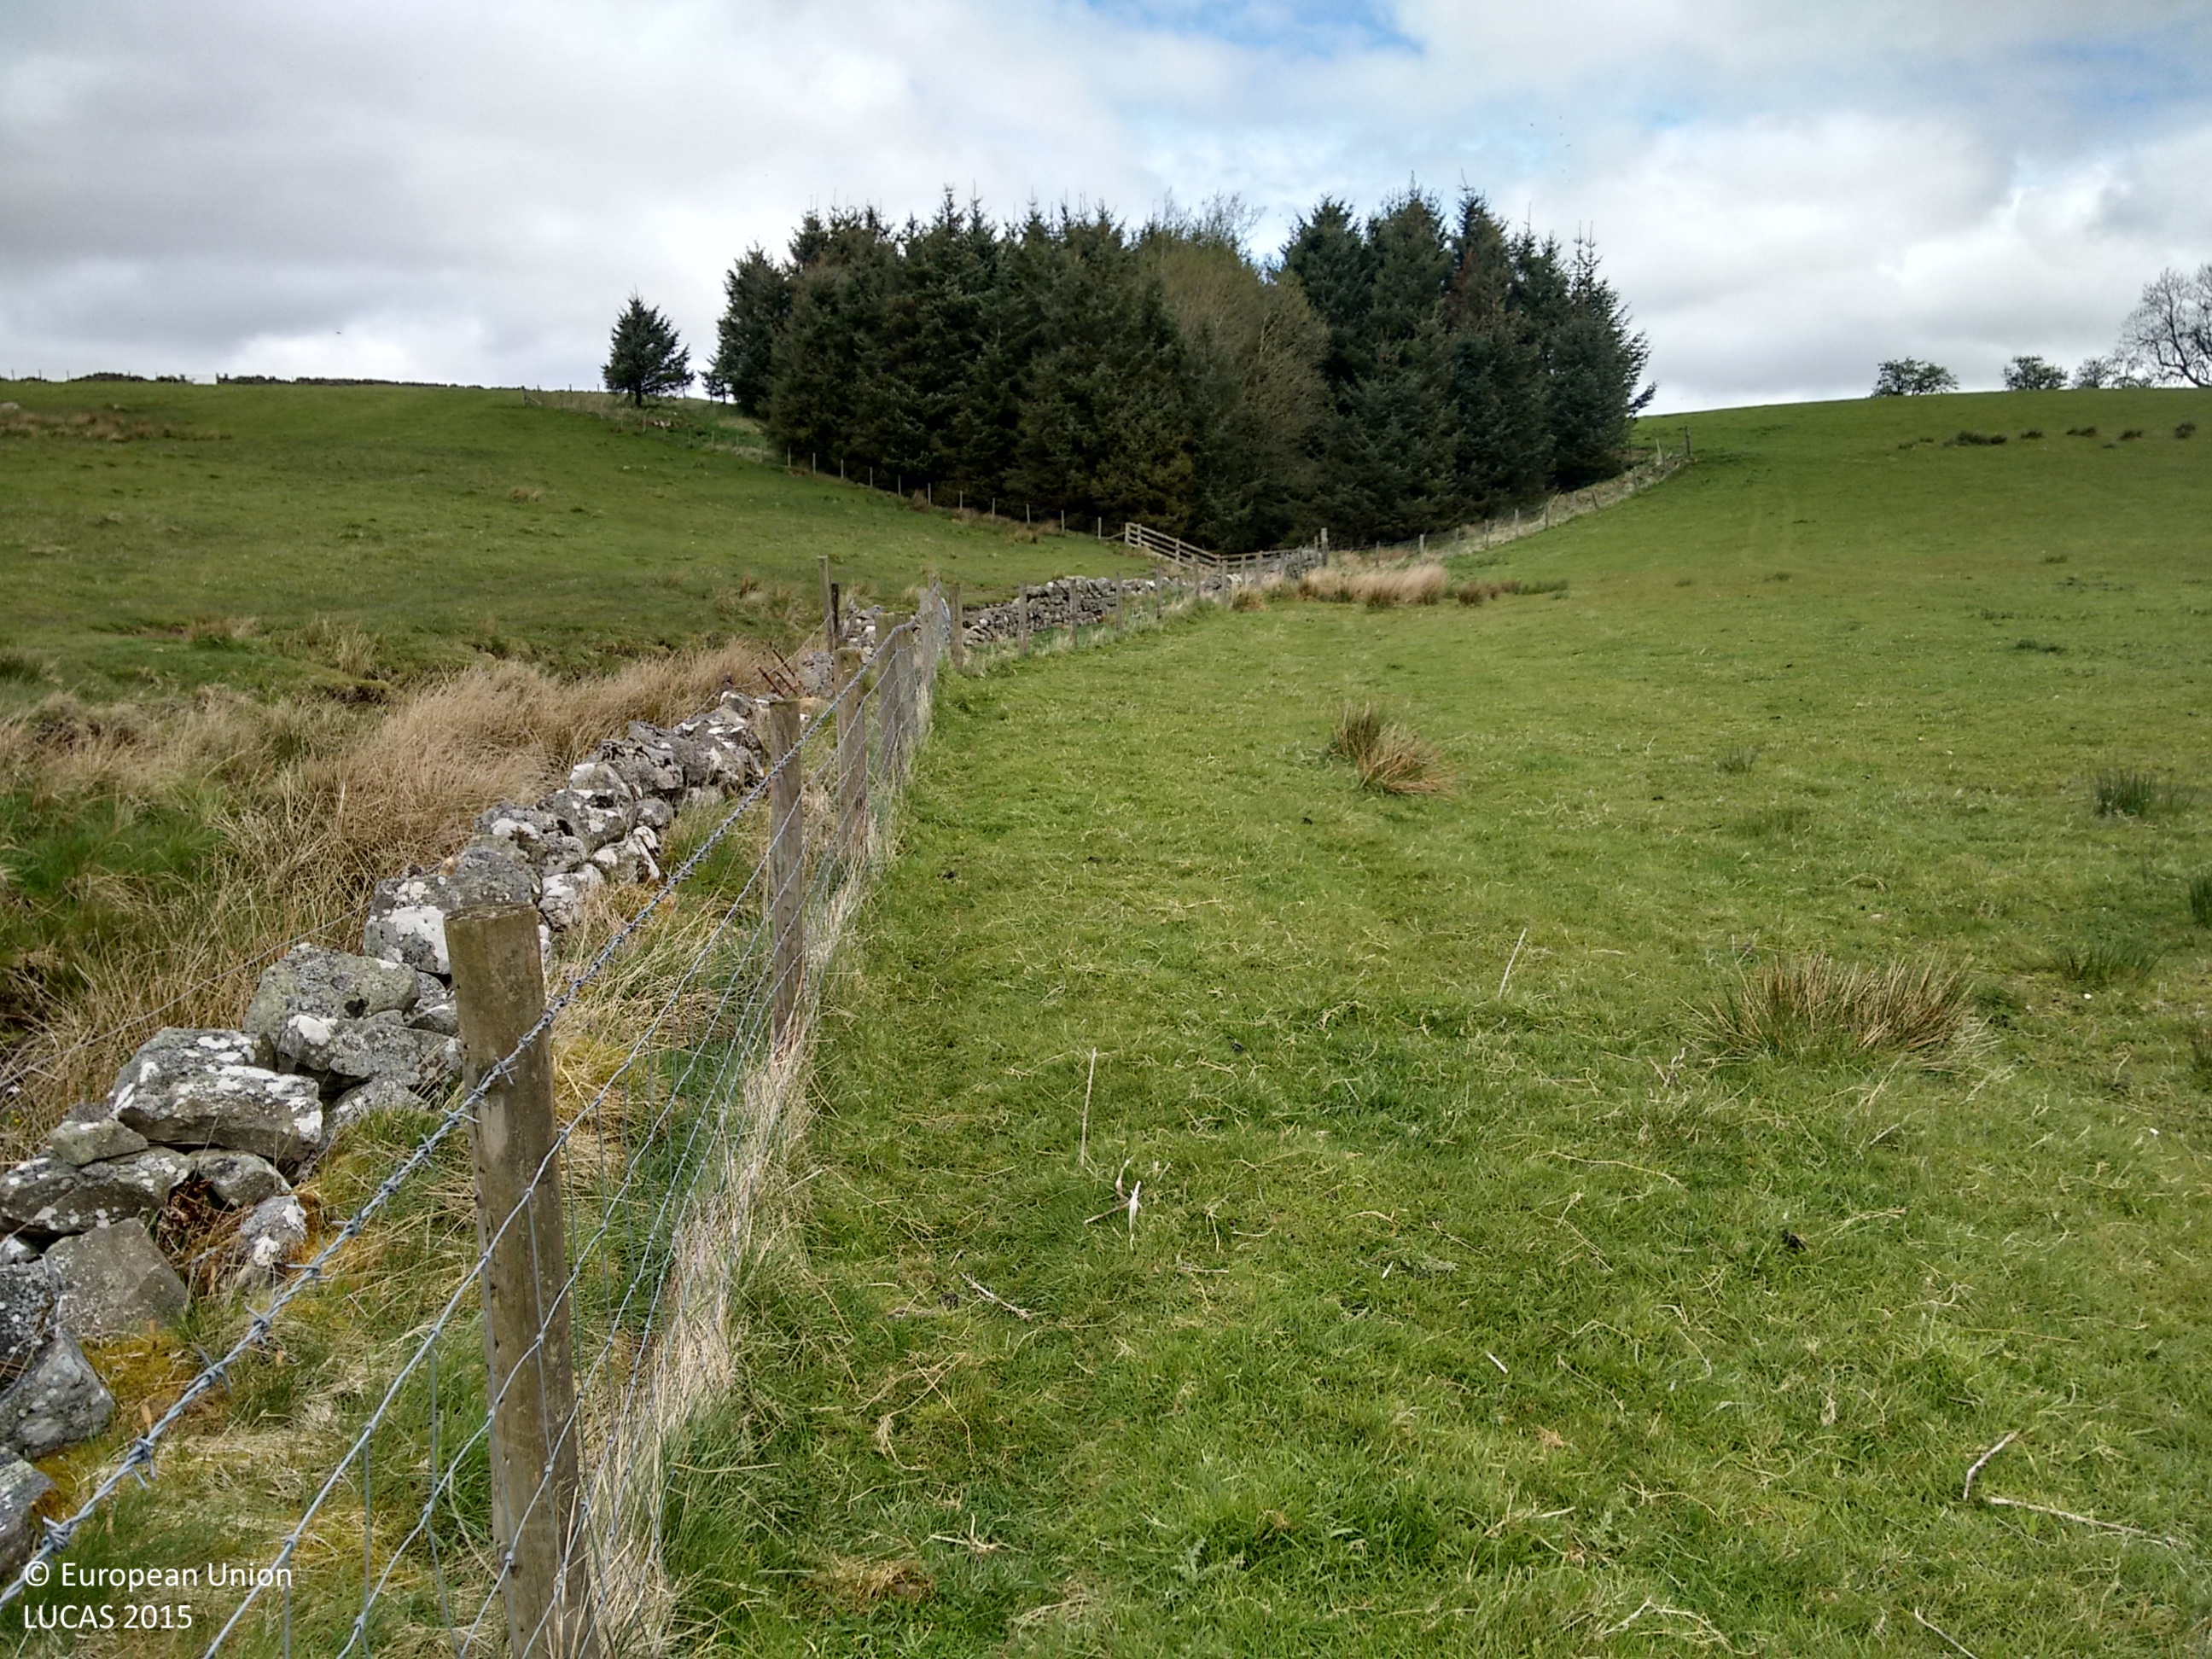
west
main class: Grassland
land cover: Grassland without tree/shrub cover
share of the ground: > 75 %
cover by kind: herbaceous plants 100 %
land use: Agriculture (excluding fallow land and kitchen gardens)
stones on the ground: < 10 %
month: May
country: GB
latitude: 55.2259
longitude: -2.1460
